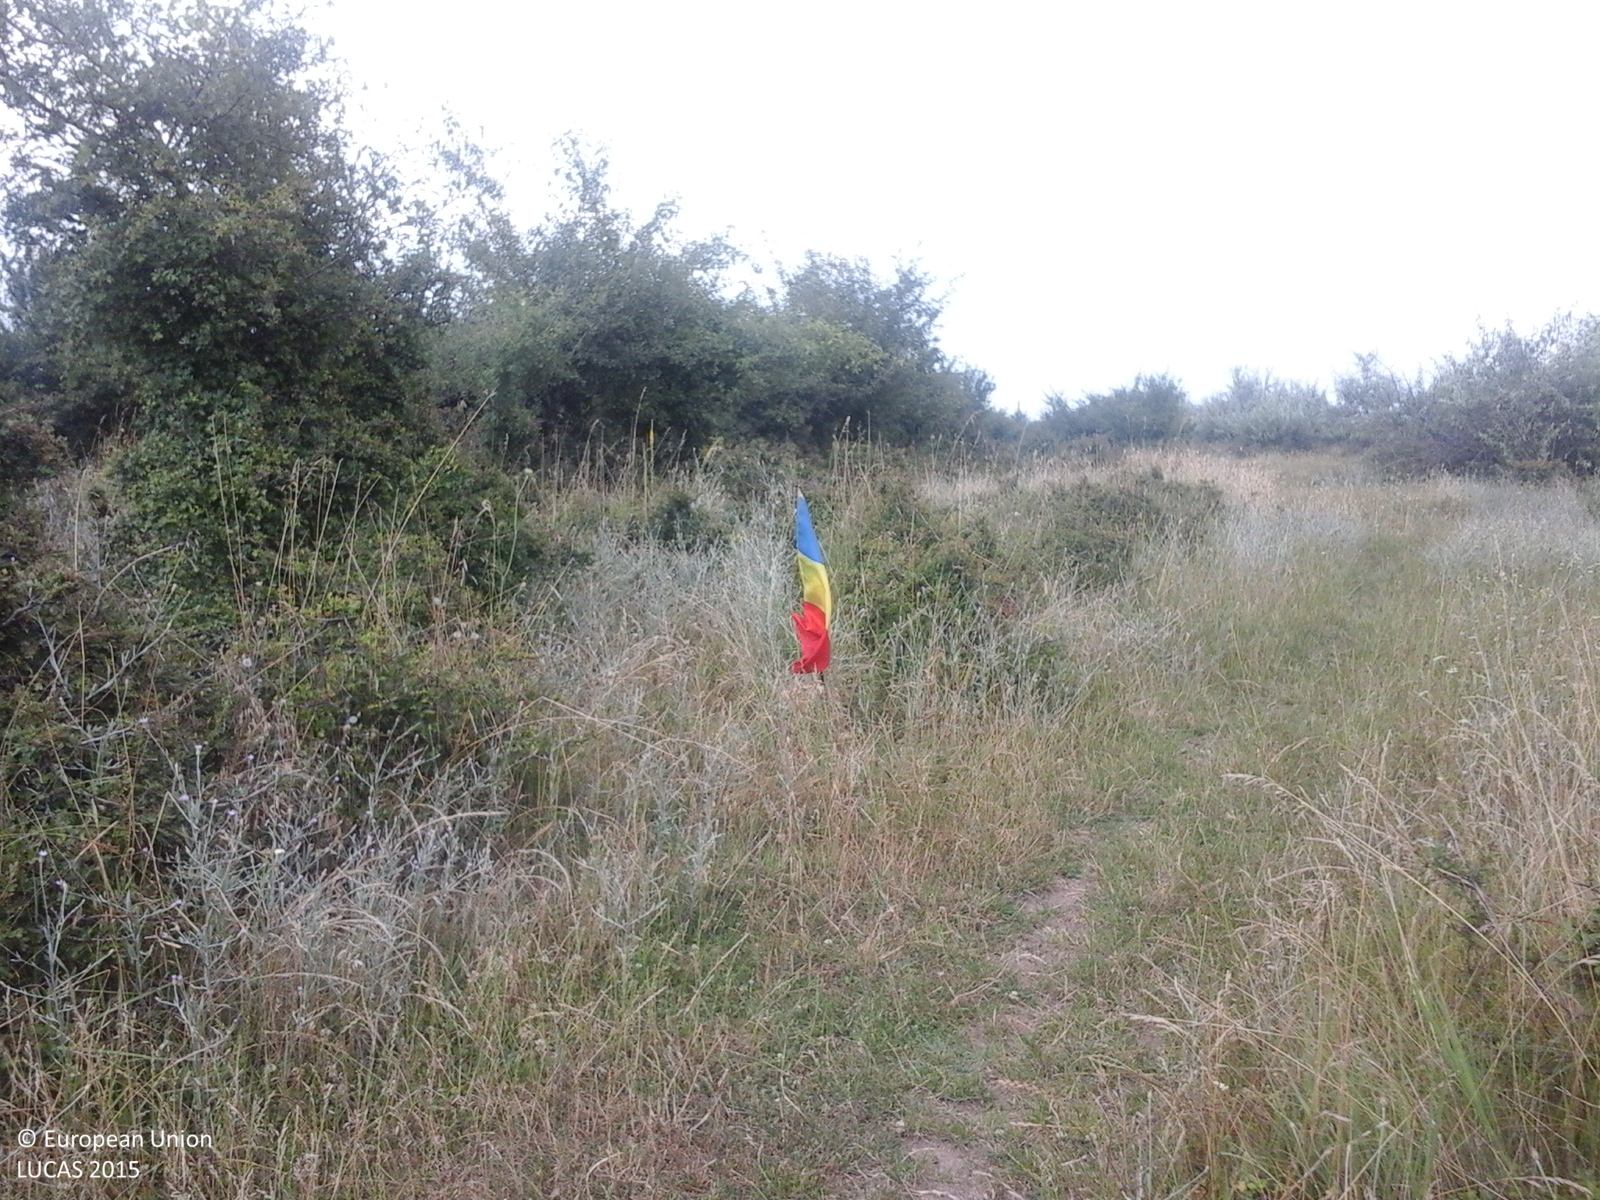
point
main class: Shrubland
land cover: Shrubland with sparse tree cover
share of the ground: > 75 %
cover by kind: shrubs 75 %, herbaceous plants 20 %, broadleaved forest trees 5 %
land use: Abandoned areas
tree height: < 5 m
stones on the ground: < 10 %
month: July
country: RO
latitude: 44.1718
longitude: 25.2287
